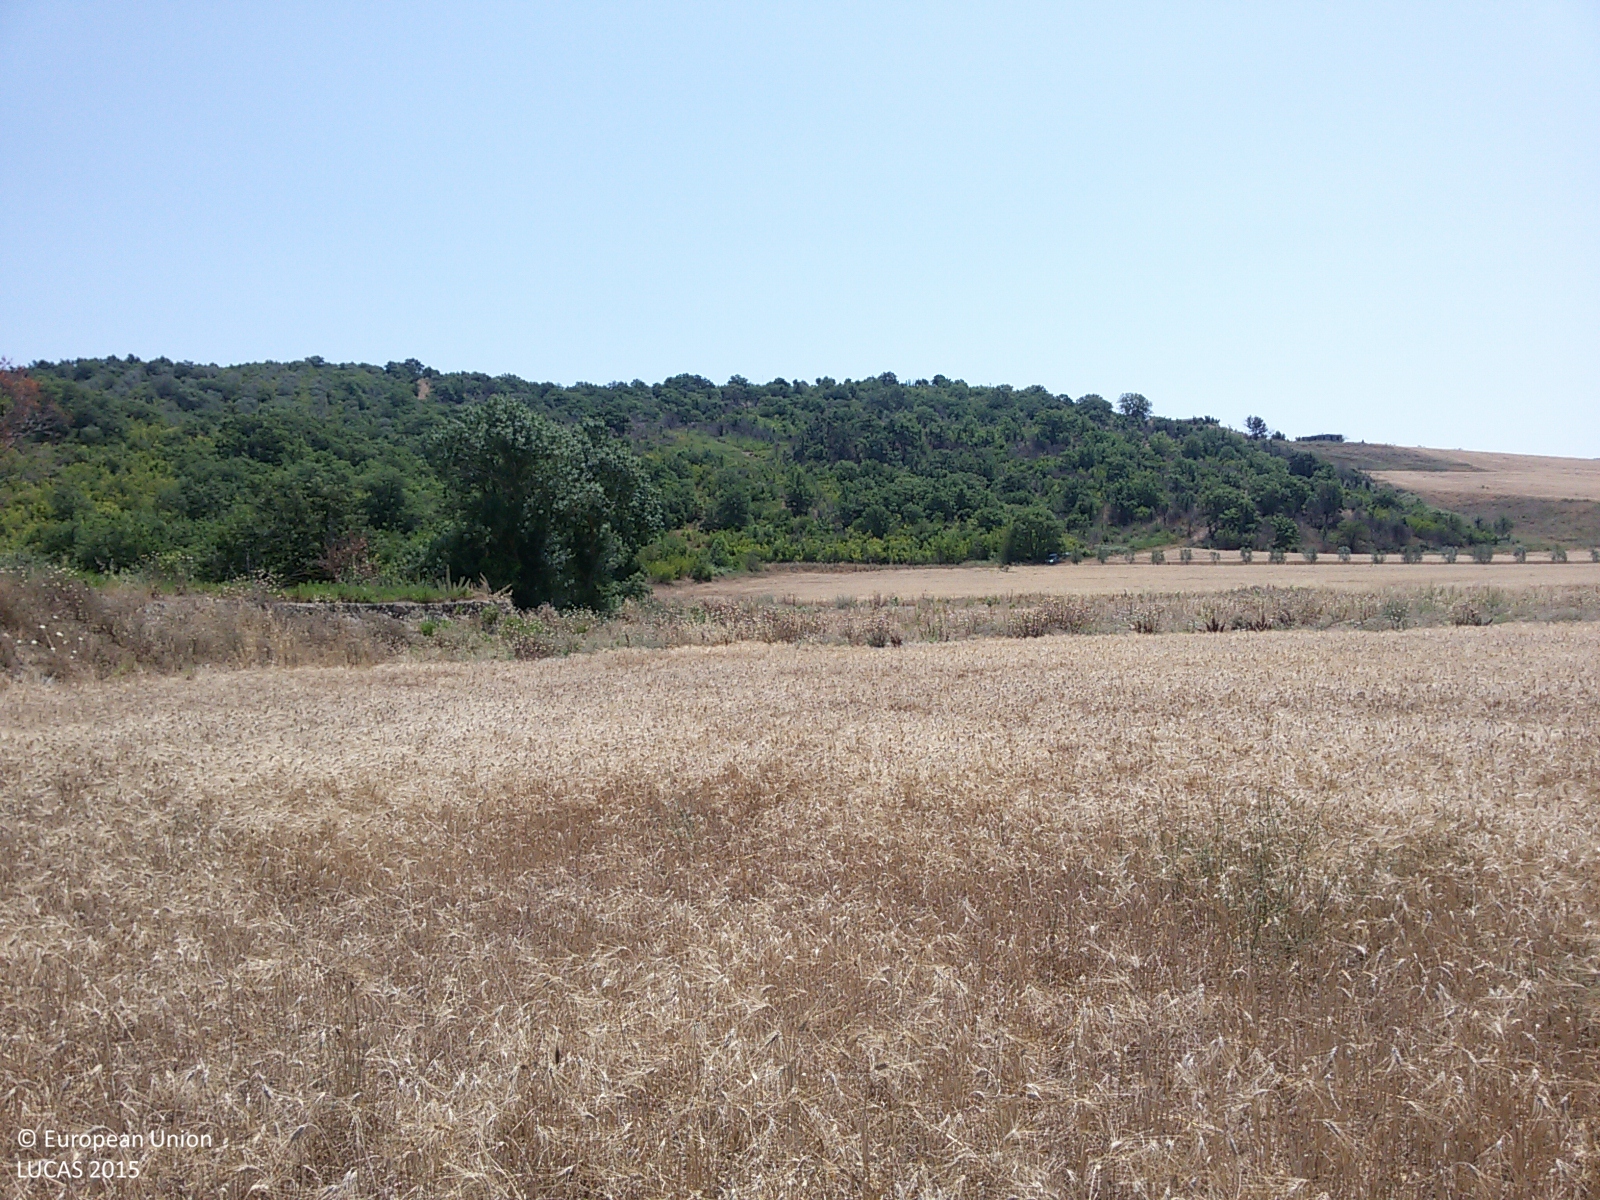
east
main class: Cropland
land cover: Durum wheat
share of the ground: > 75 %
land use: Agriculture (excluding fallow land and kitchen gardens)
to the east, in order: Durum wheat; Other structural elements; Grass margins; Abandoned hedges; Shrubland with sparse tree cover; Broadleaved woodland
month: July
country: IT
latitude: 42.6256
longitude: 11.4461
